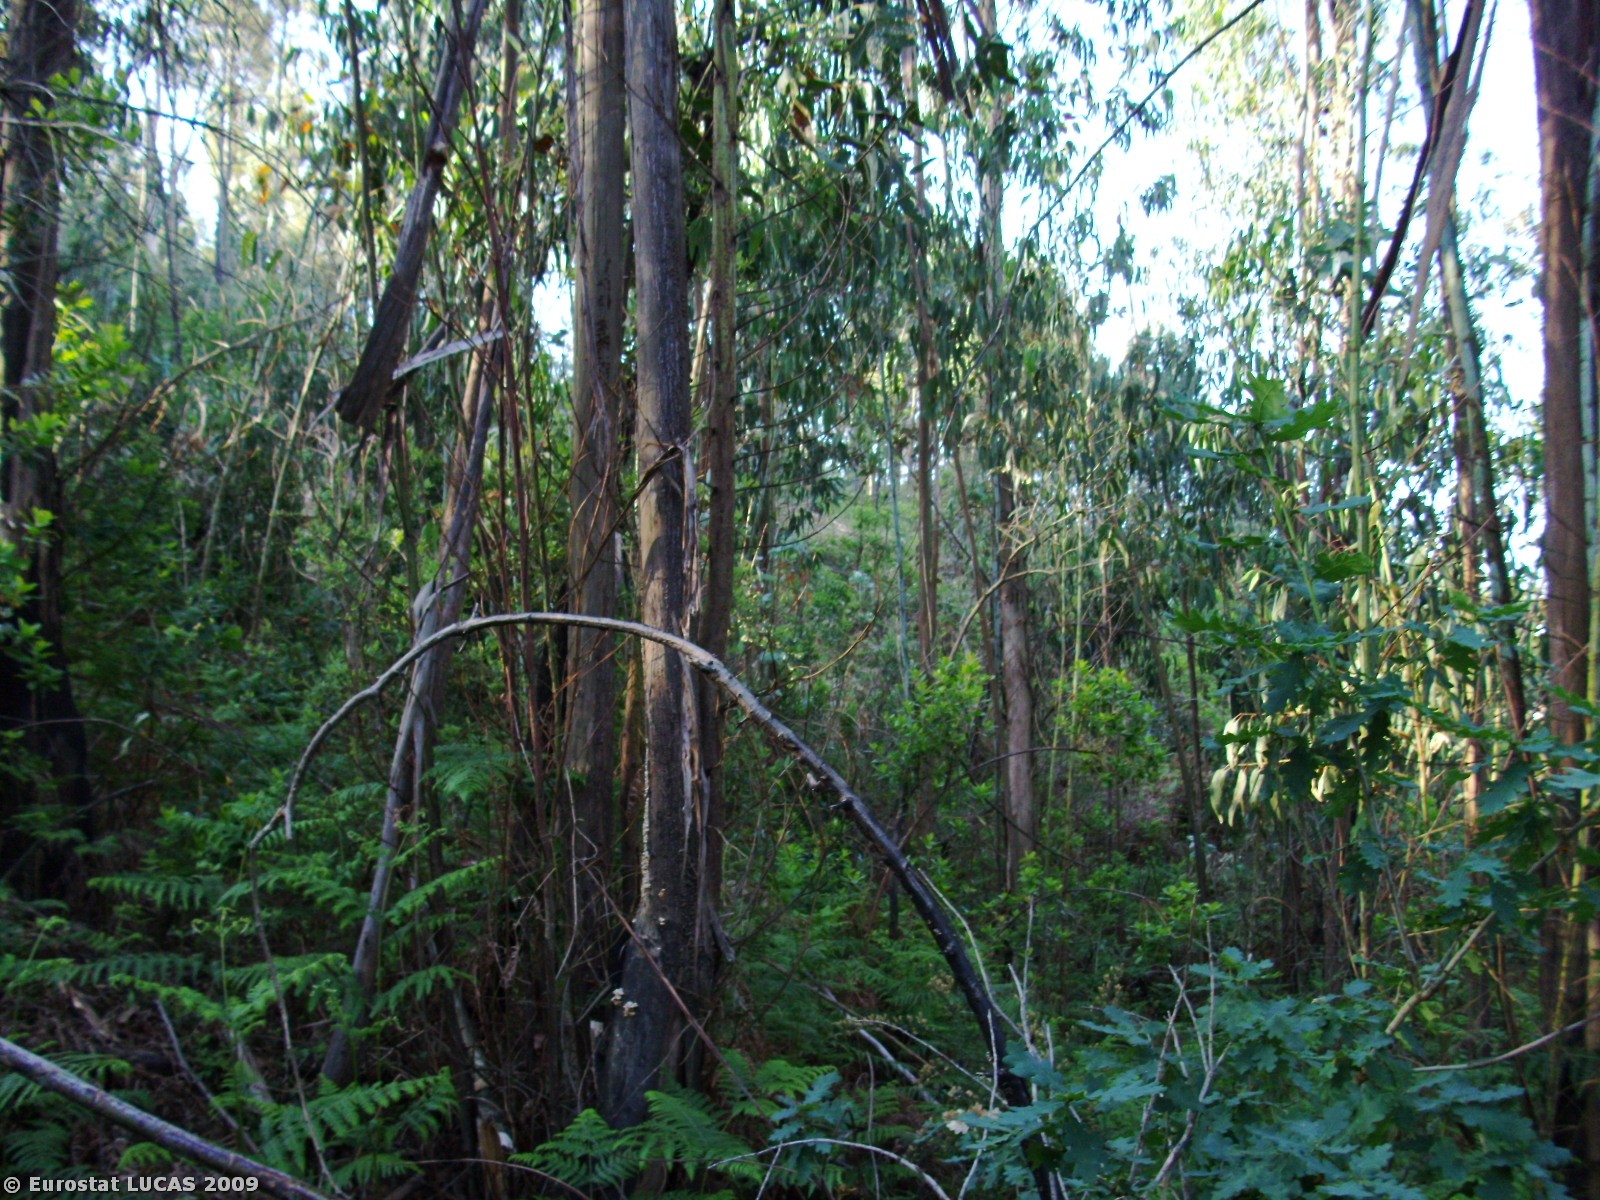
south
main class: Woodland
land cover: Broadleaved woodland
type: plantations and self-sown exotic forest
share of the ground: 50 - 75 %
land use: Forestry
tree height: > 5 m
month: May
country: PT
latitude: 40.8282
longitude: -8.4629
